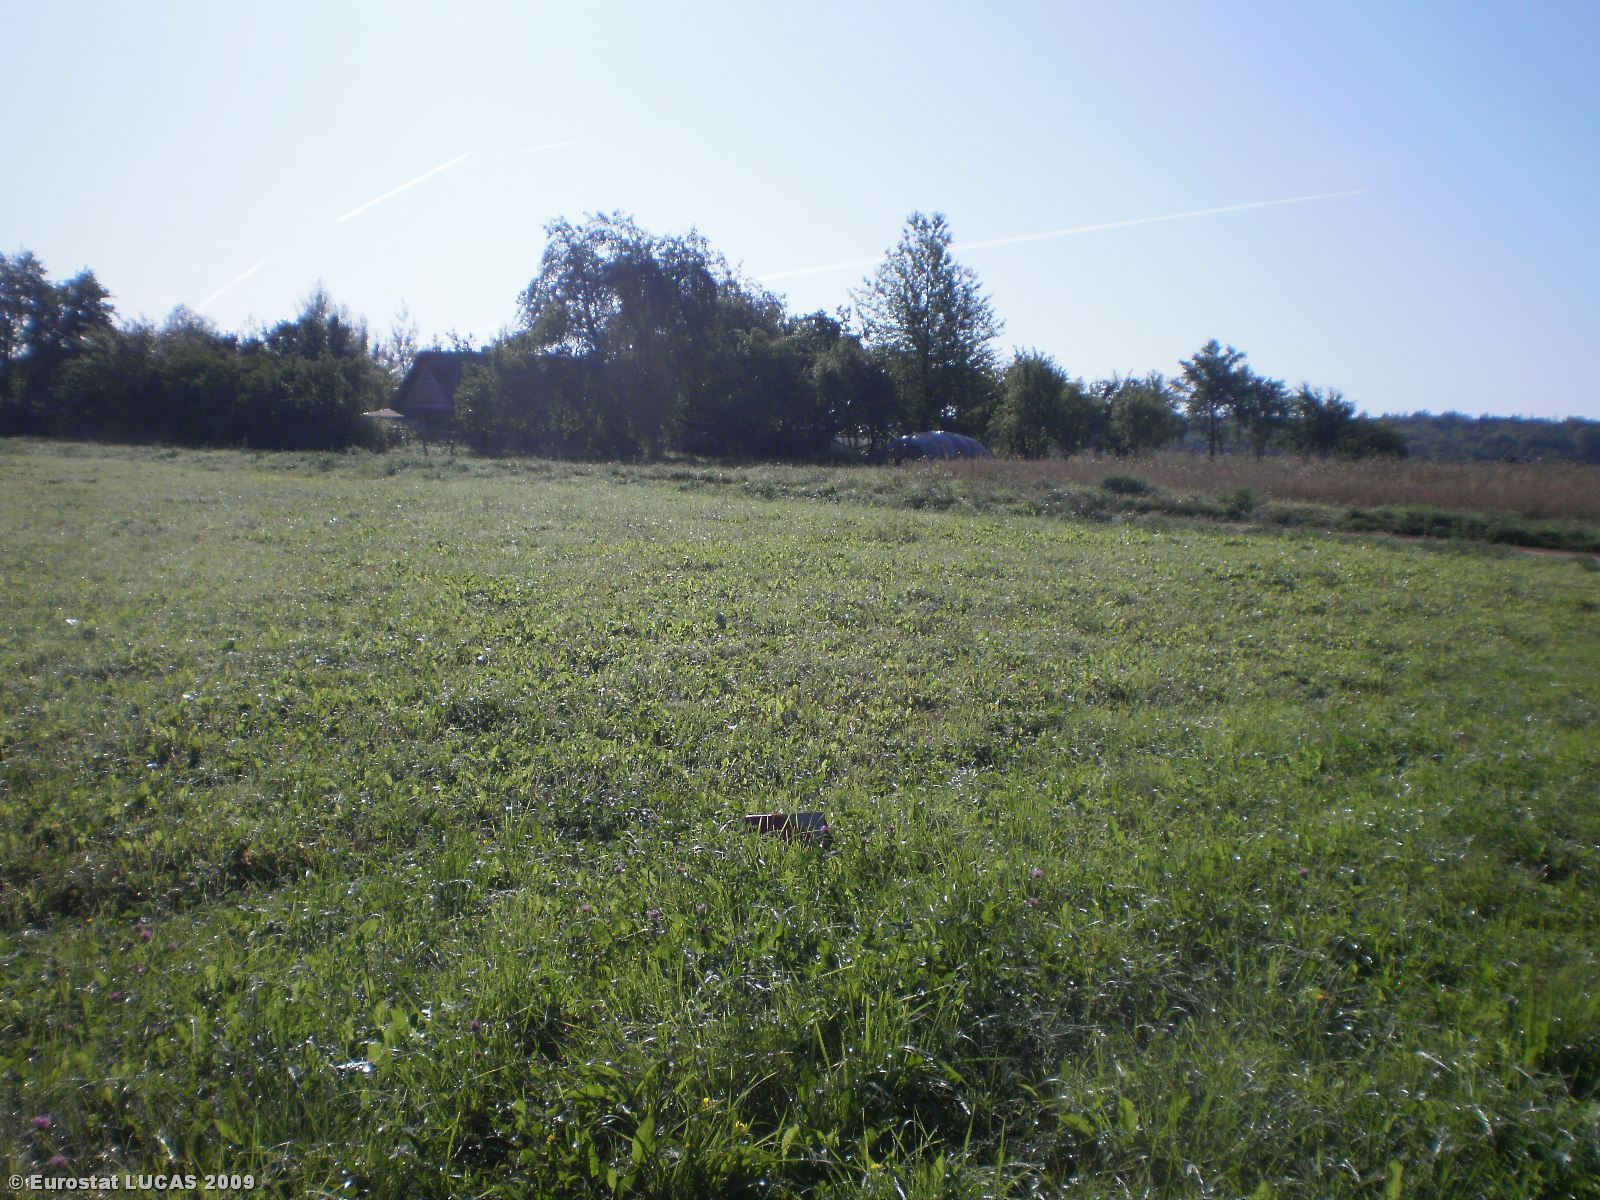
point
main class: Grassland
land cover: Grassland without tree/shrub cover
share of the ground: > 75 %
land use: Agriculture (excluding fallow land and kitchen gardens)
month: August
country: LT
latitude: 54.9597
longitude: 24.7728
